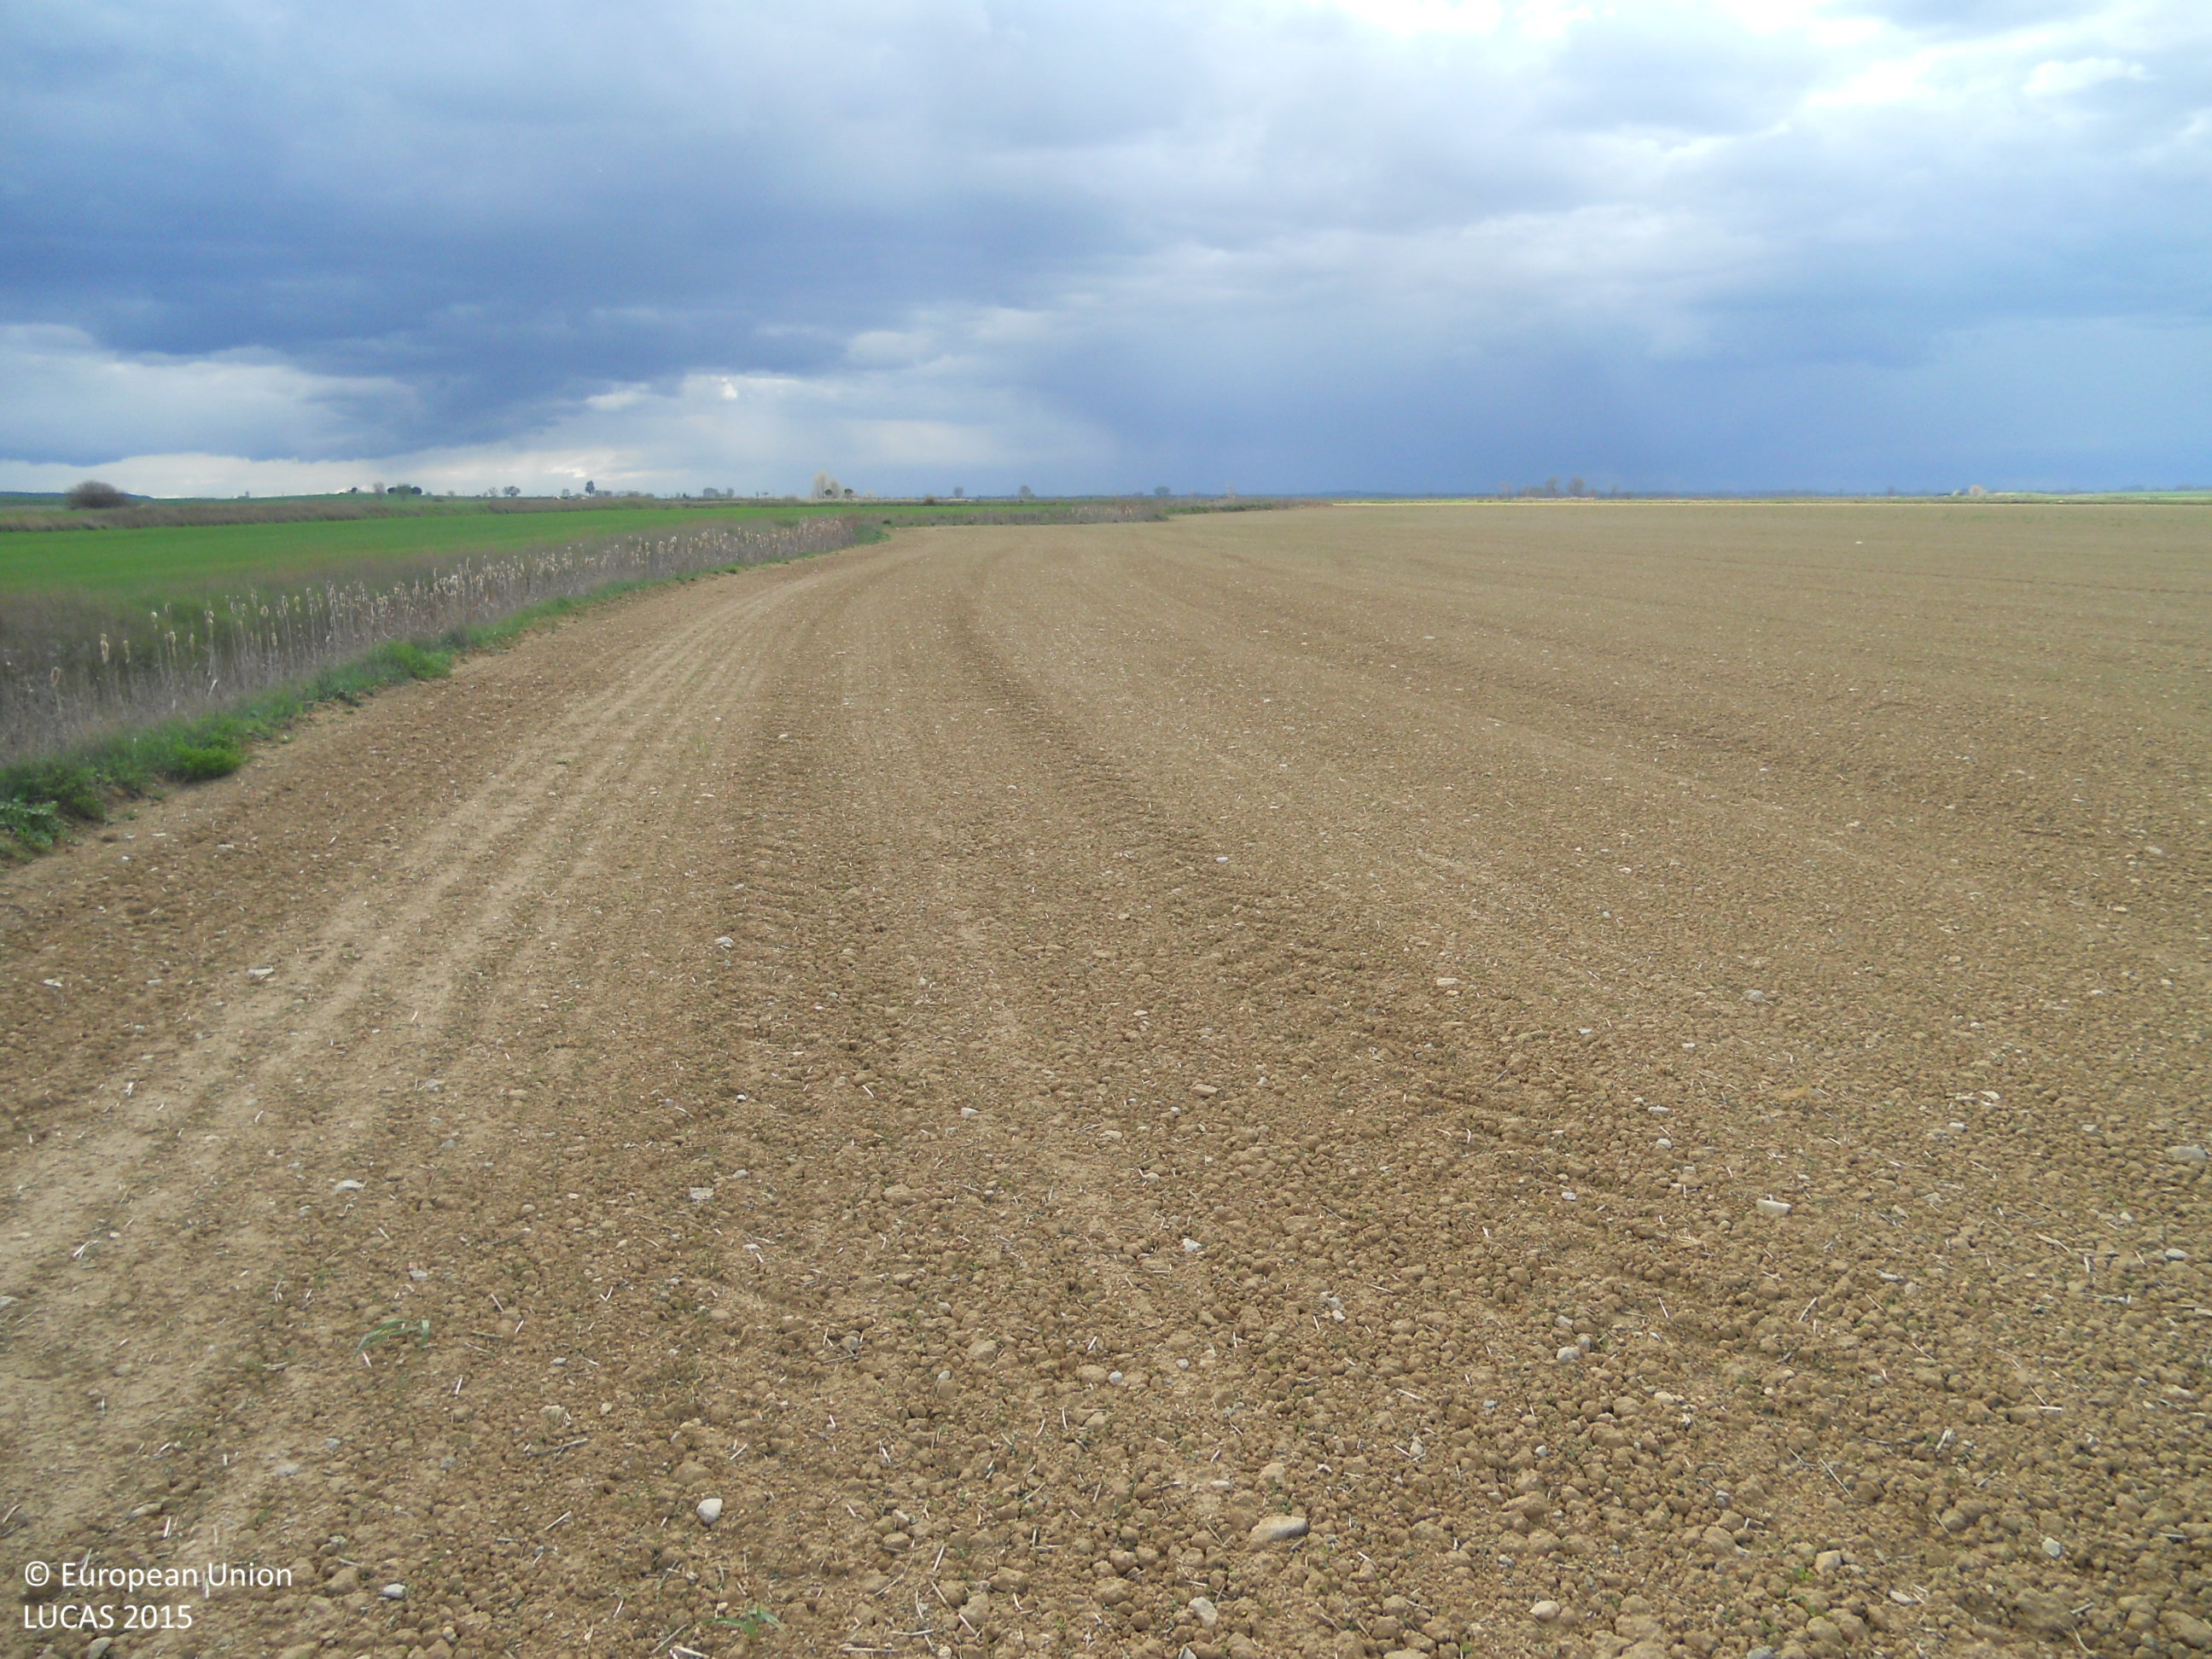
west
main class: Cropland
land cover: Lucerne
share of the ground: < 10 %
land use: Agriculture (excluding fallow land and kitchen gardens)
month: April
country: ES
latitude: 42.2332
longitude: -4.3313
